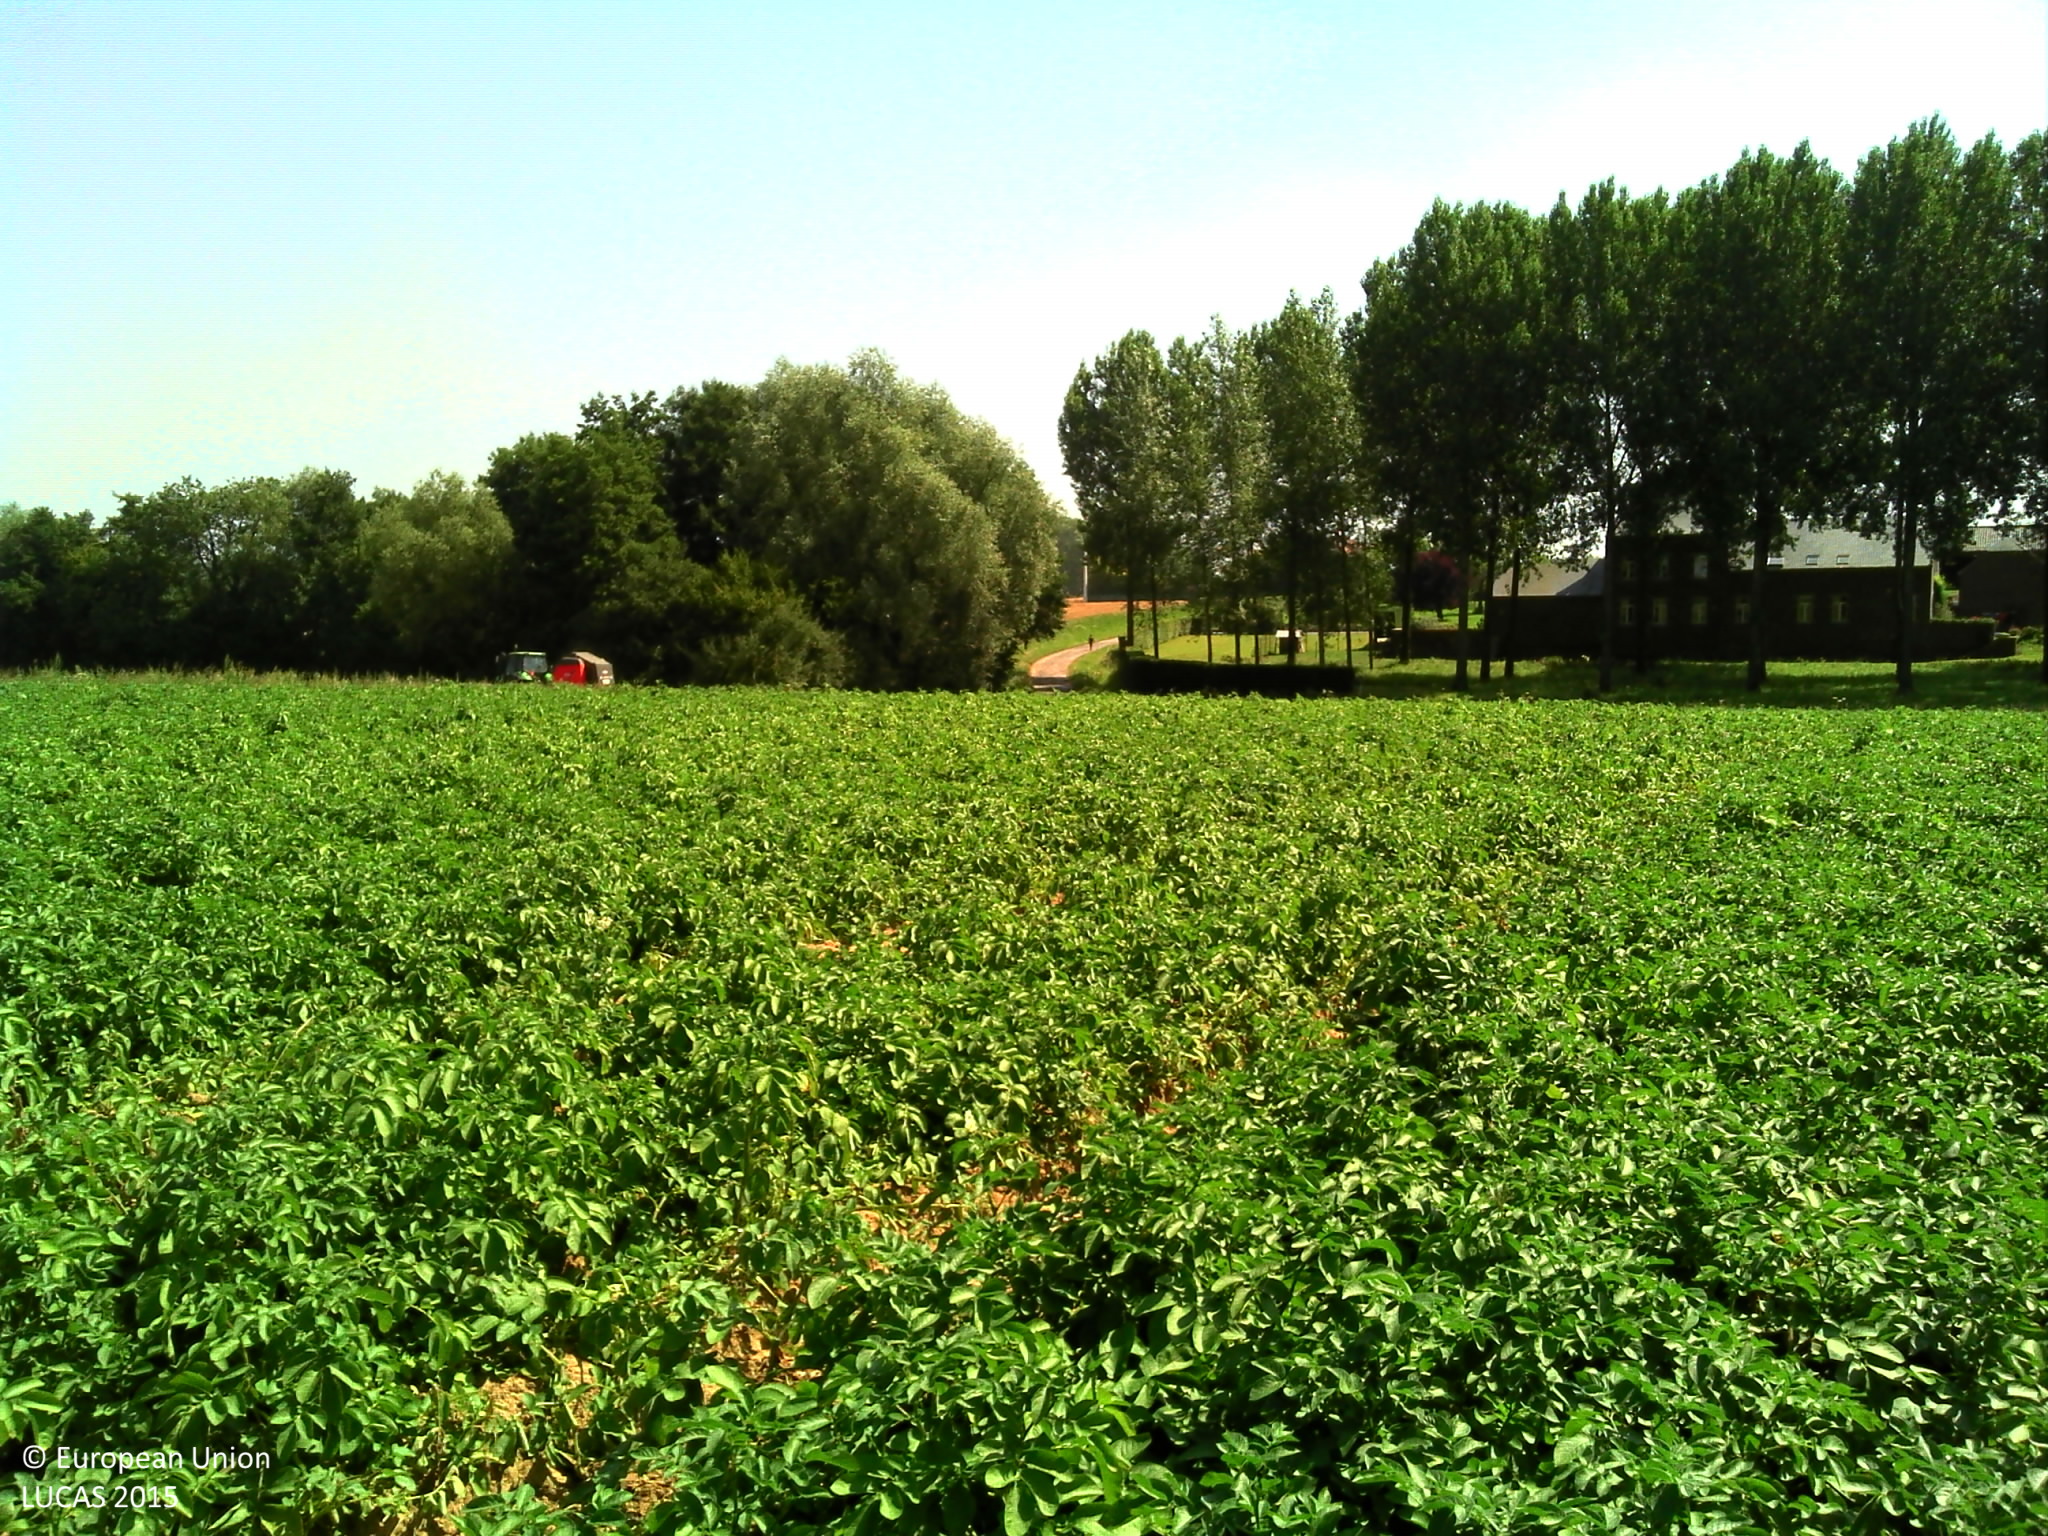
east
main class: Cropland
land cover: Potatoes
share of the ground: > 75 %
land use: Agriculture (excluding fallow land and kitchen gardens)
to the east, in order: Potatoes; Grassland without tree/shrub cover; Ditches and canals; Grass margins; Tracks; Grass margins; Ditches and canals; Grass margins; Broadleaved woodland; Artificial constructions in urban areas; Grassland with sparse tree/shrub cover
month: August
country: FR
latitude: 50.3296
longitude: 3.9395
